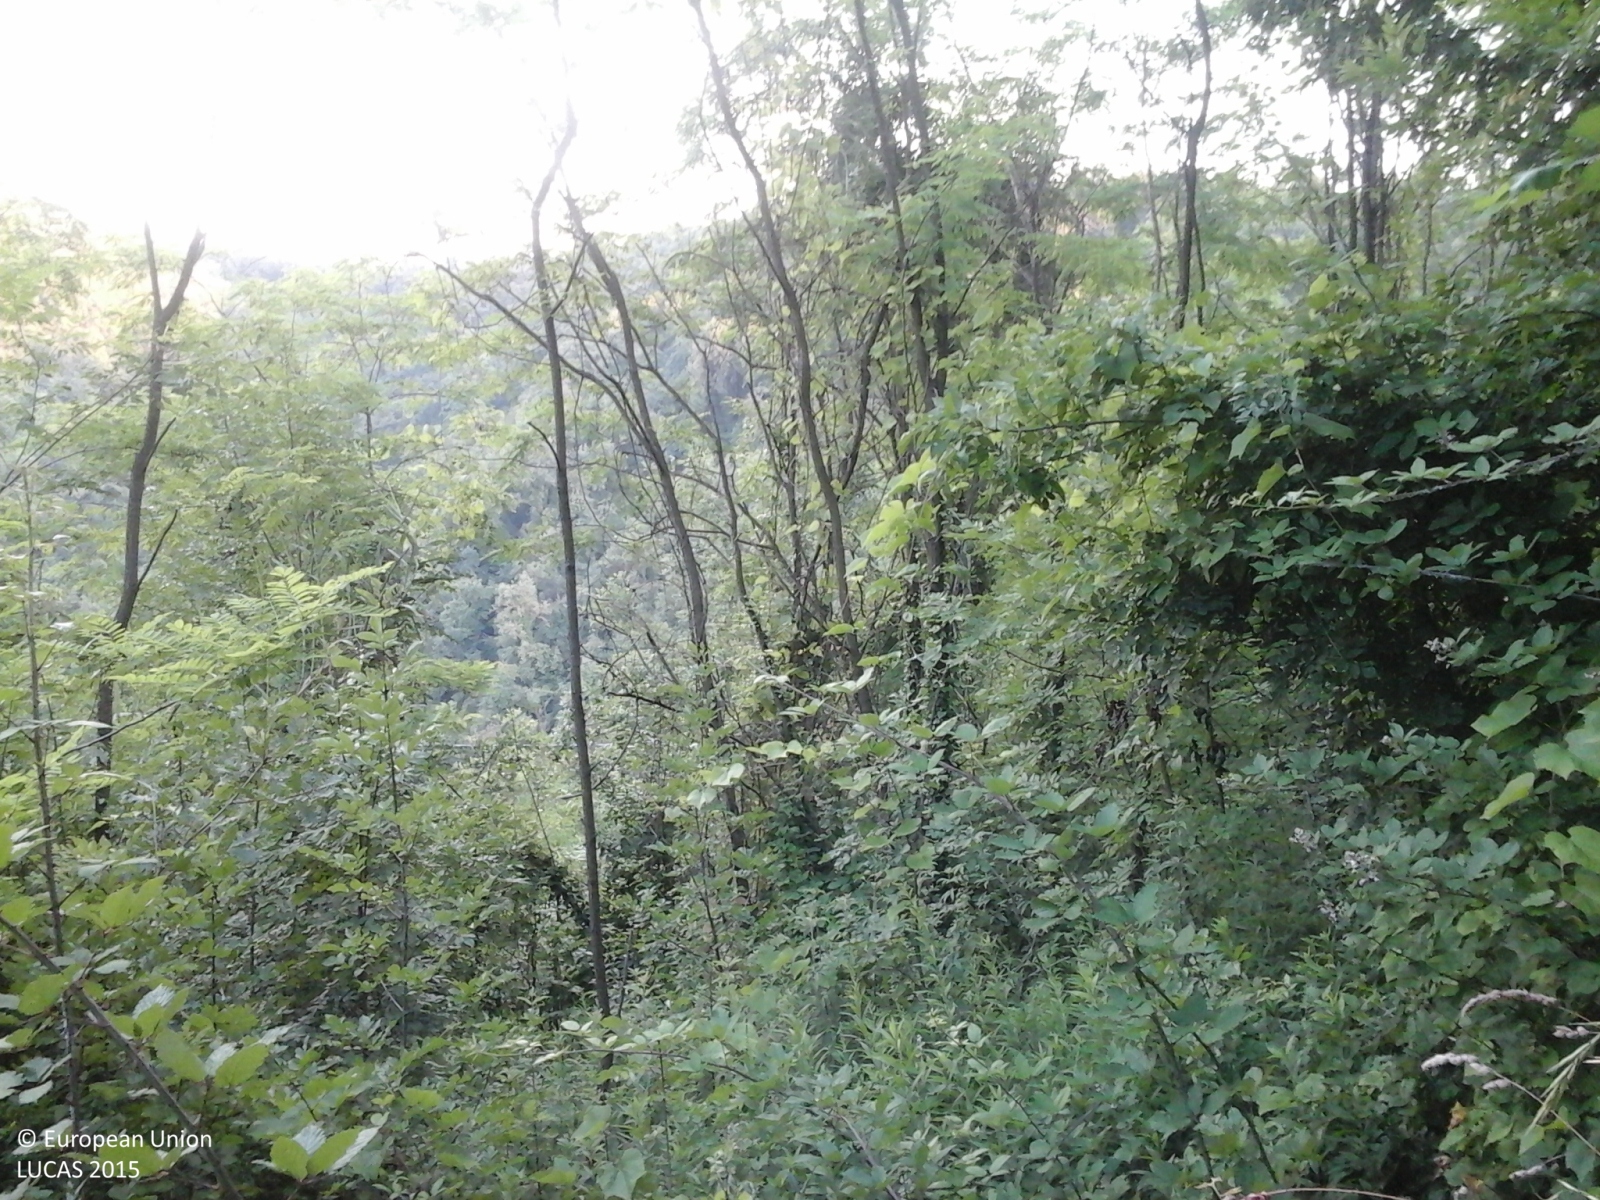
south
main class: Woodland
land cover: Broadleaved woodland
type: thermophilous deciduous forest
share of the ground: > 75 %
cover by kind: broadleaved forest trees 100 %
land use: Semi-natural and natural areas not in use
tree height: > 5 m
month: June
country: IT
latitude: 45.0583
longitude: 8.3142
